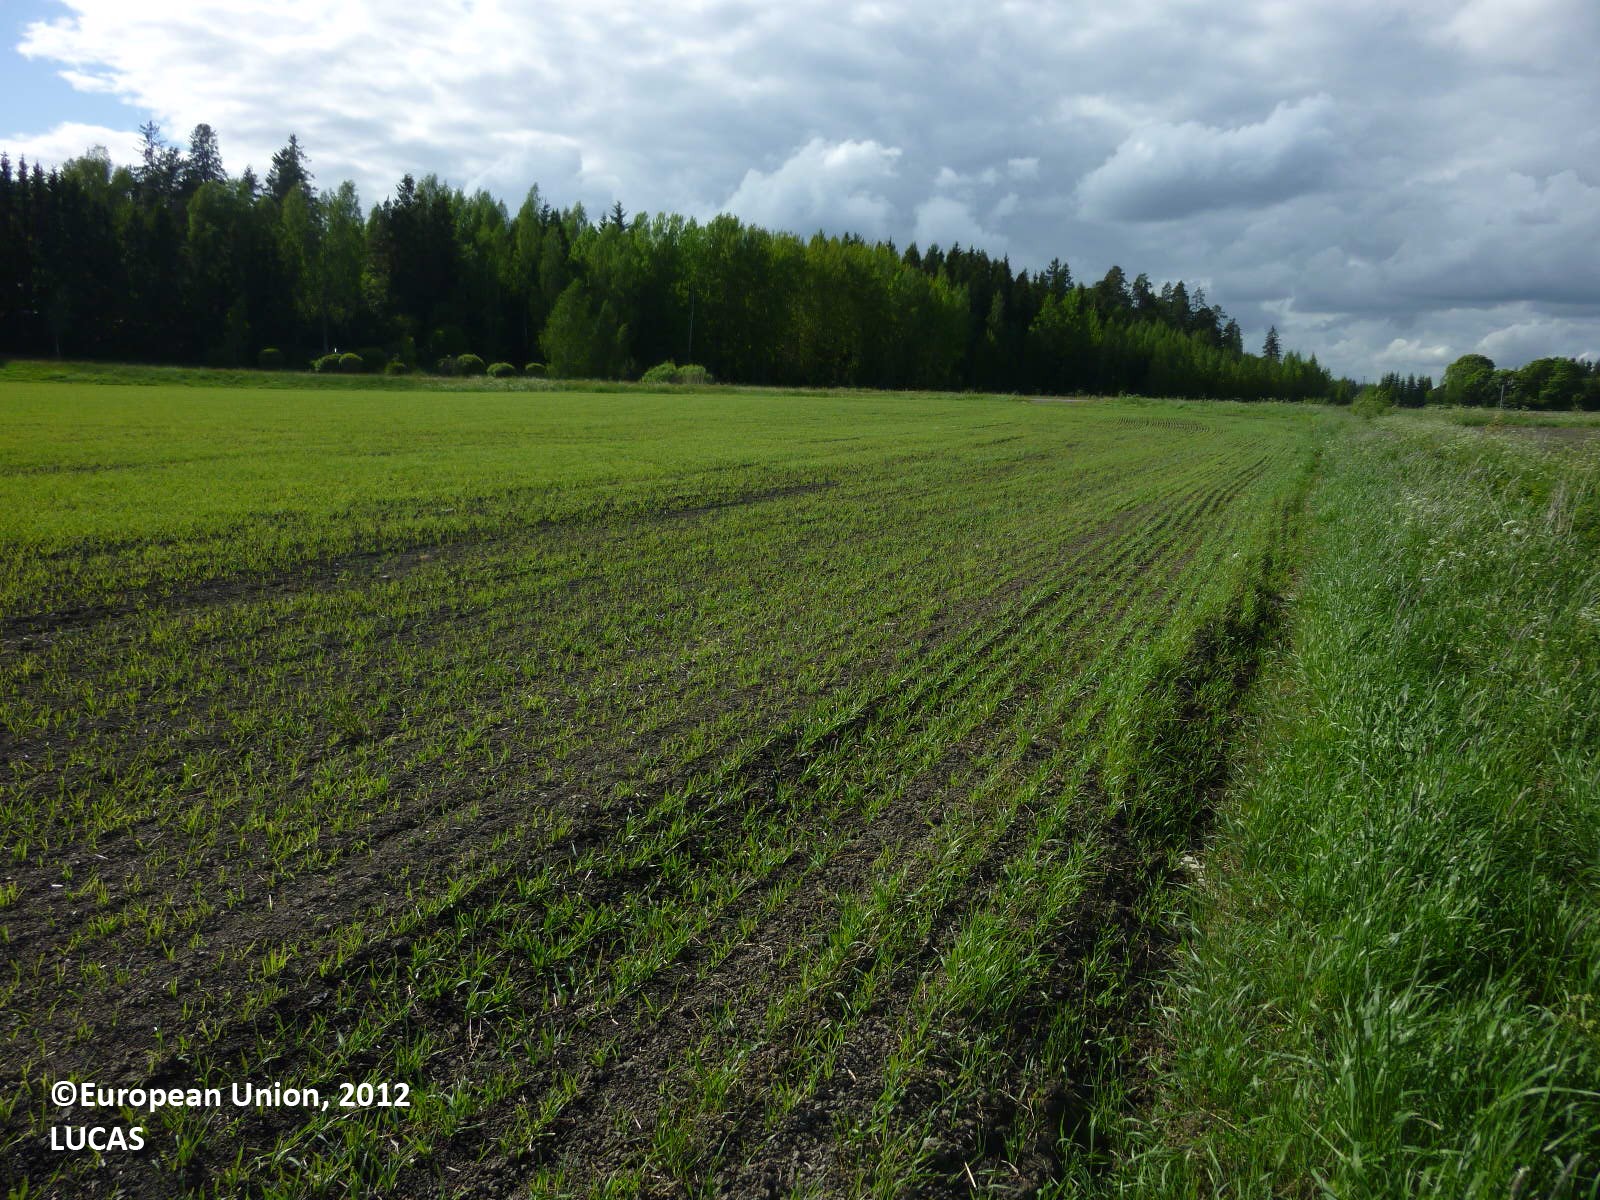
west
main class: Cropland
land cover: Barley
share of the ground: > 75 %
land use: Agriculture (excluding fallow land and kitchen gardens)
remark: Tilled/Sowed
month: June
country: FI
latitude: 60.4678
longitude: 22.6401
